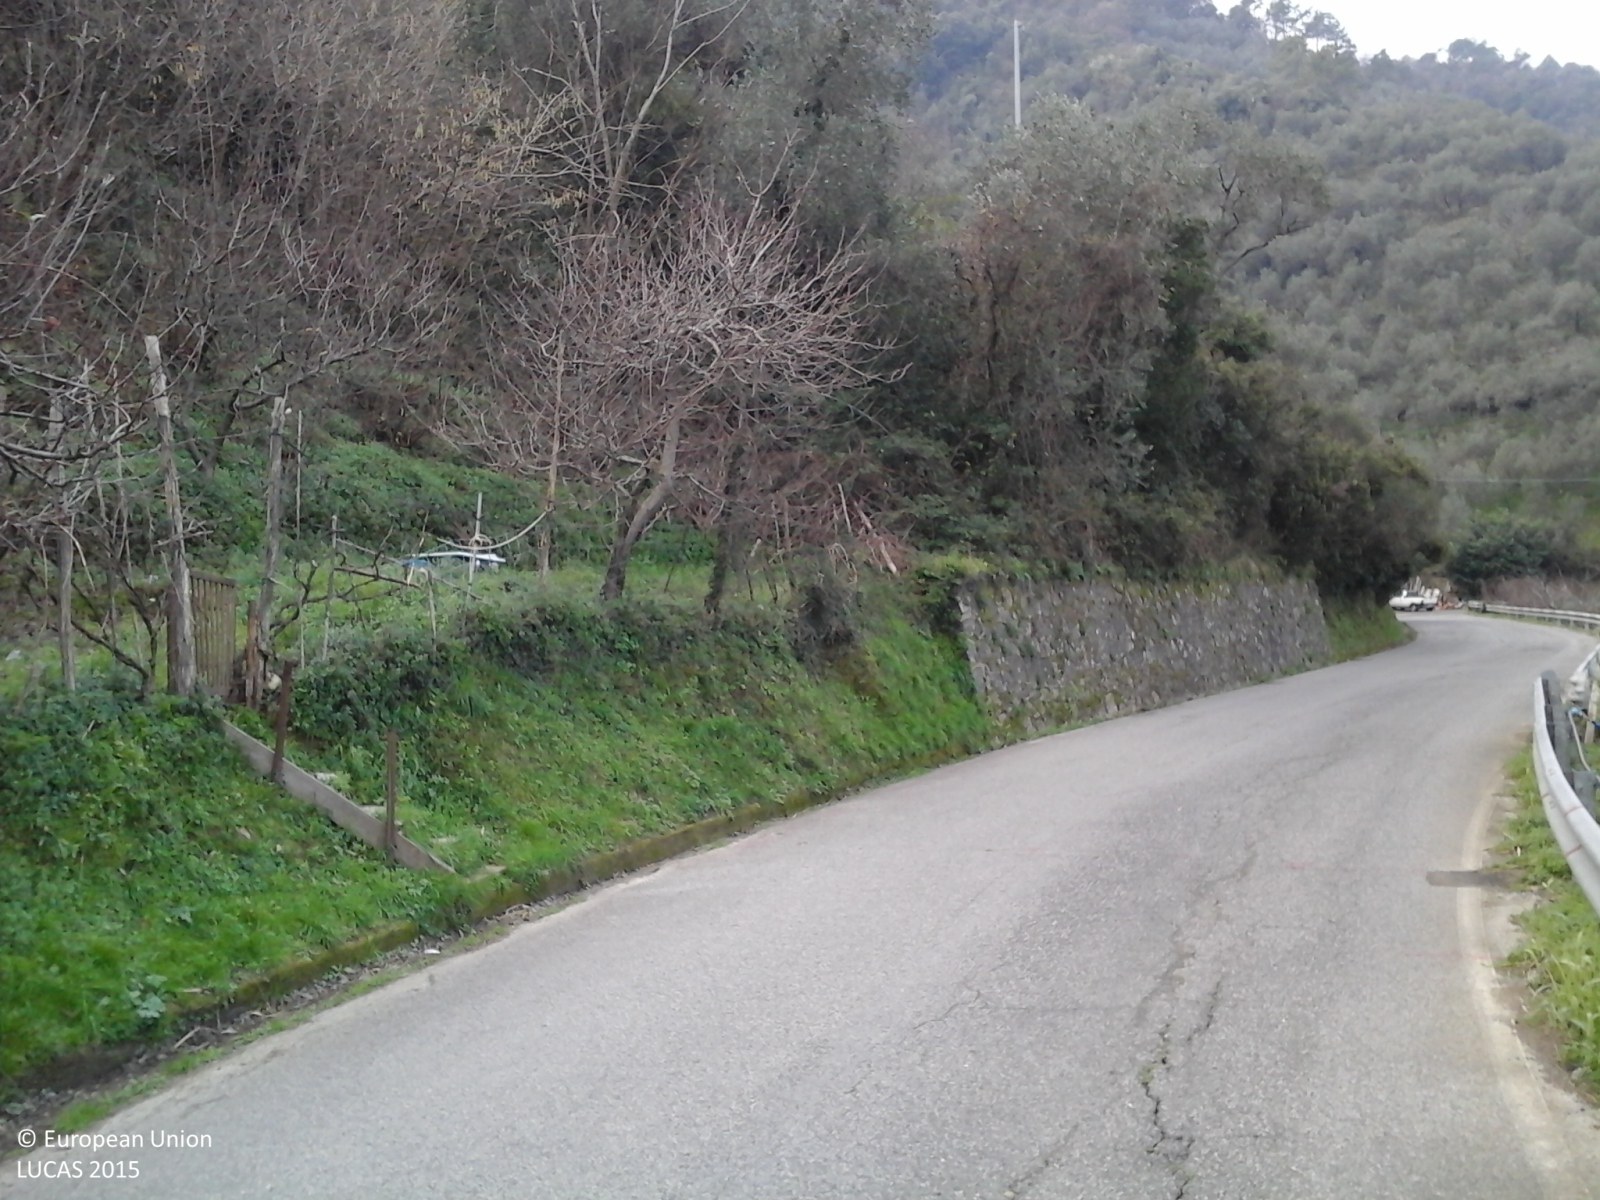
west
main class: Woodland
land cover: Broadleaved woodland
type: thermophilous deciduous forest
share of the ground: > 75 %
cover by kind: broadleaved forest trees 75 %, coniferous forest trees 10 %, shrubs 10 %, herbaceous plants 5 %
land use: Forestry
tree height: > 5 m
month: October
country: IT
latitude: 44.1875
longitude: 9.6131
